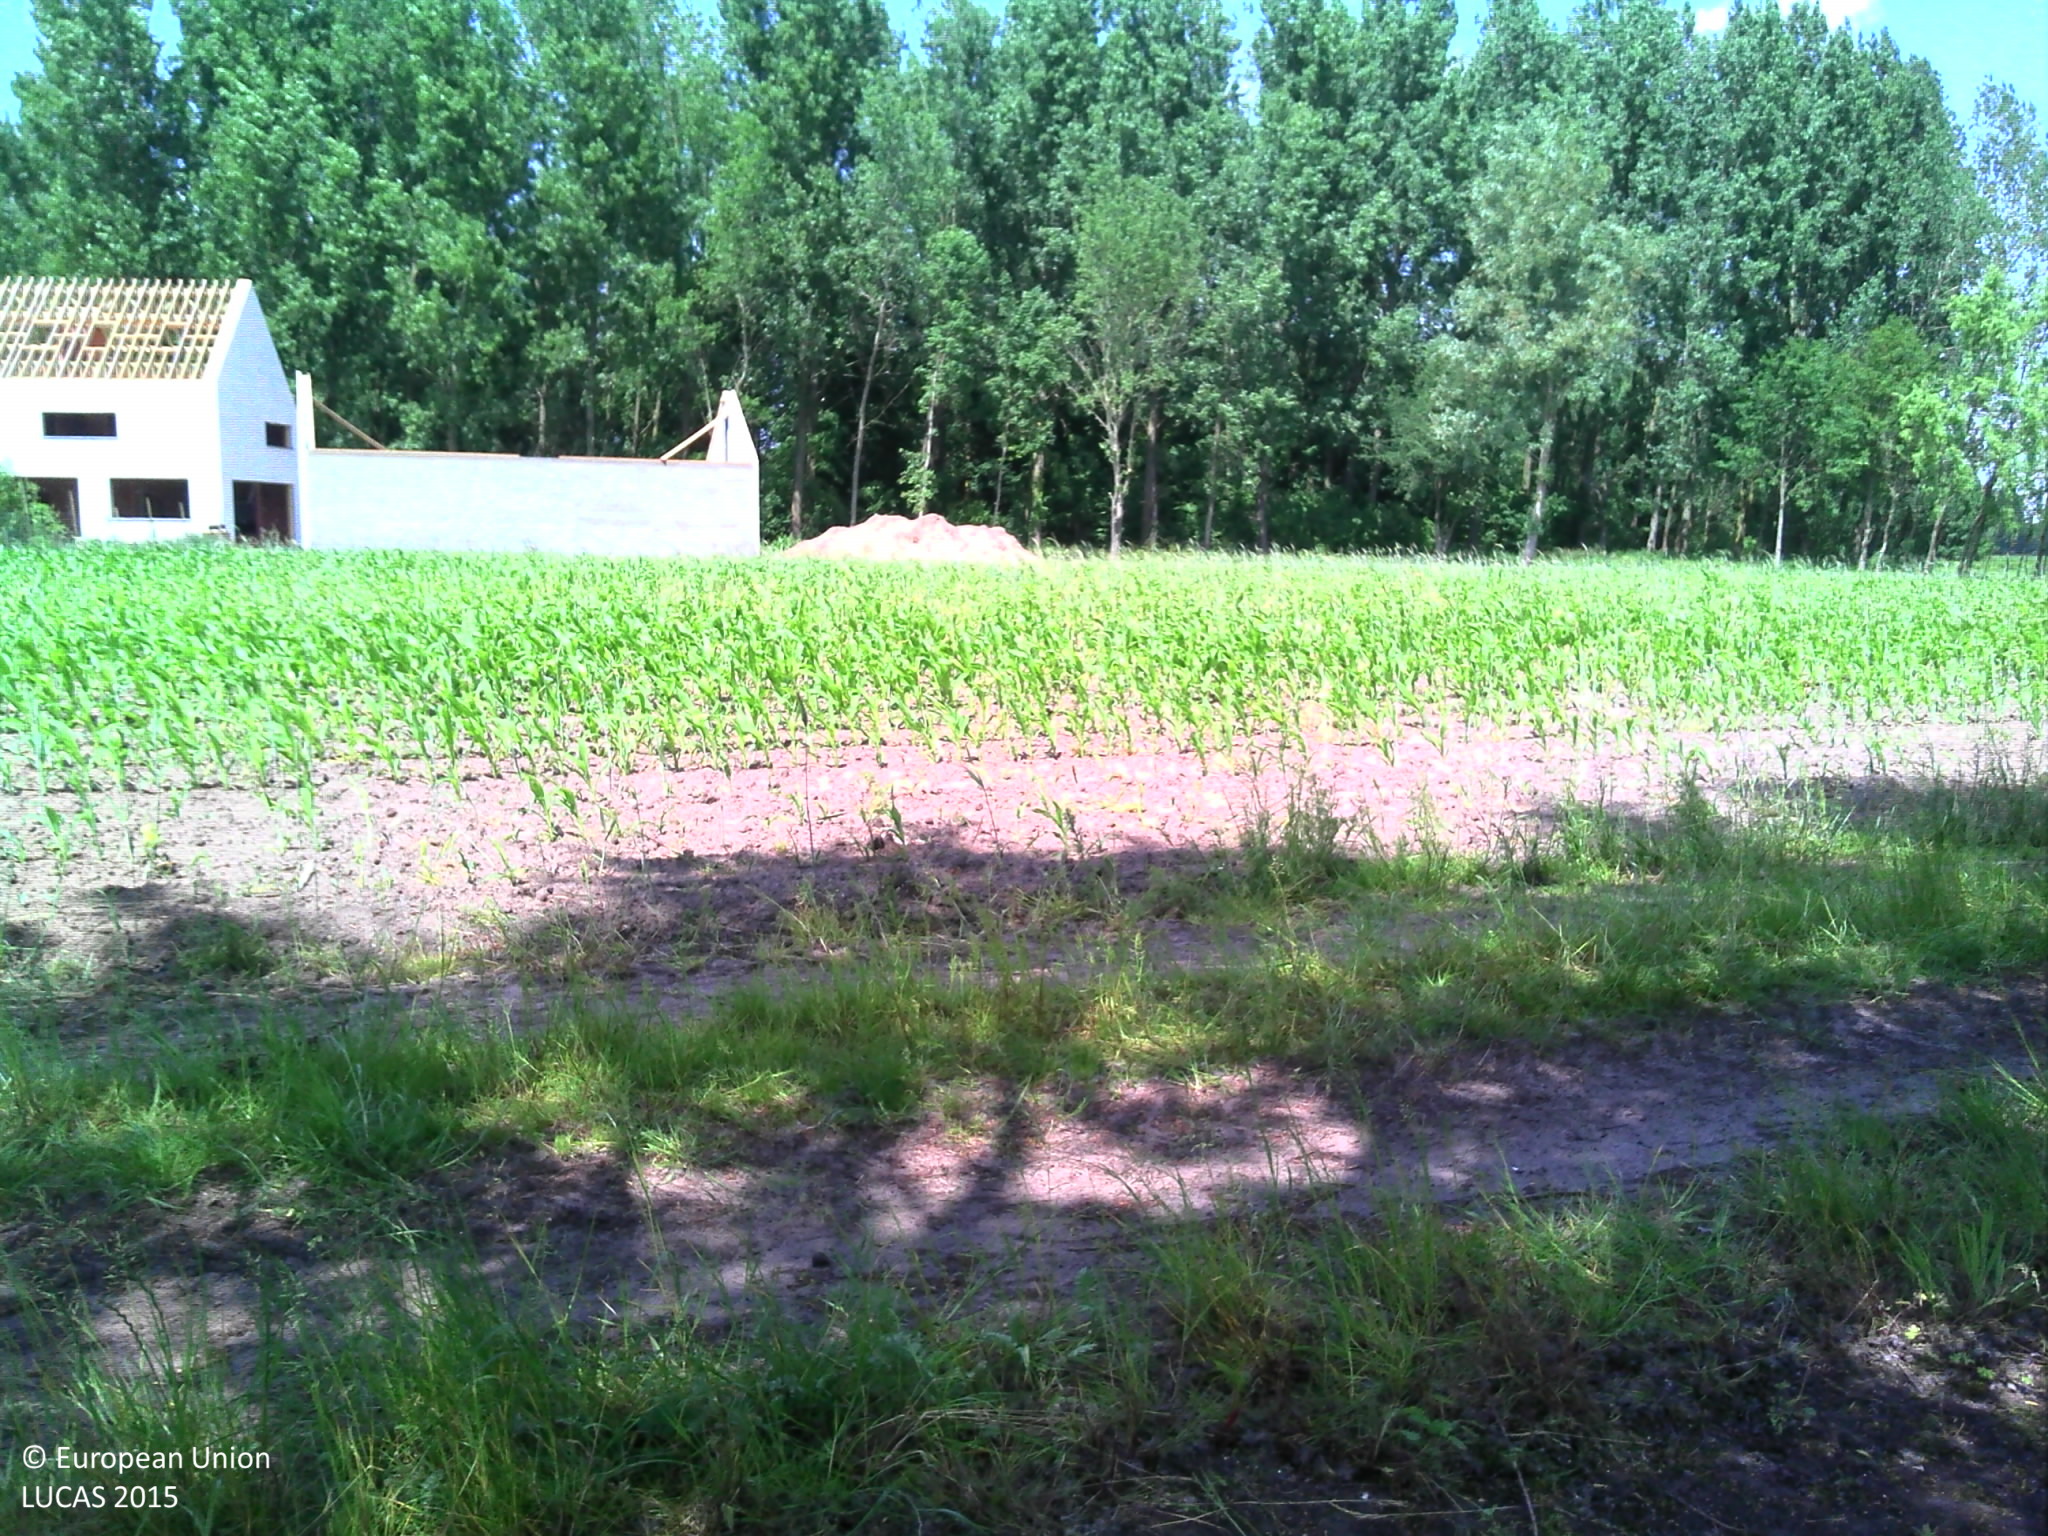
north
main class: Grassland
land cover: Grassland without tree/shrub cover
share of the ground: > 75 %
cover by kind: herbaceous plants 100 %
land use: Residential
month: June
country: BE
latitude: 51.0489
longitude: 3.9027
